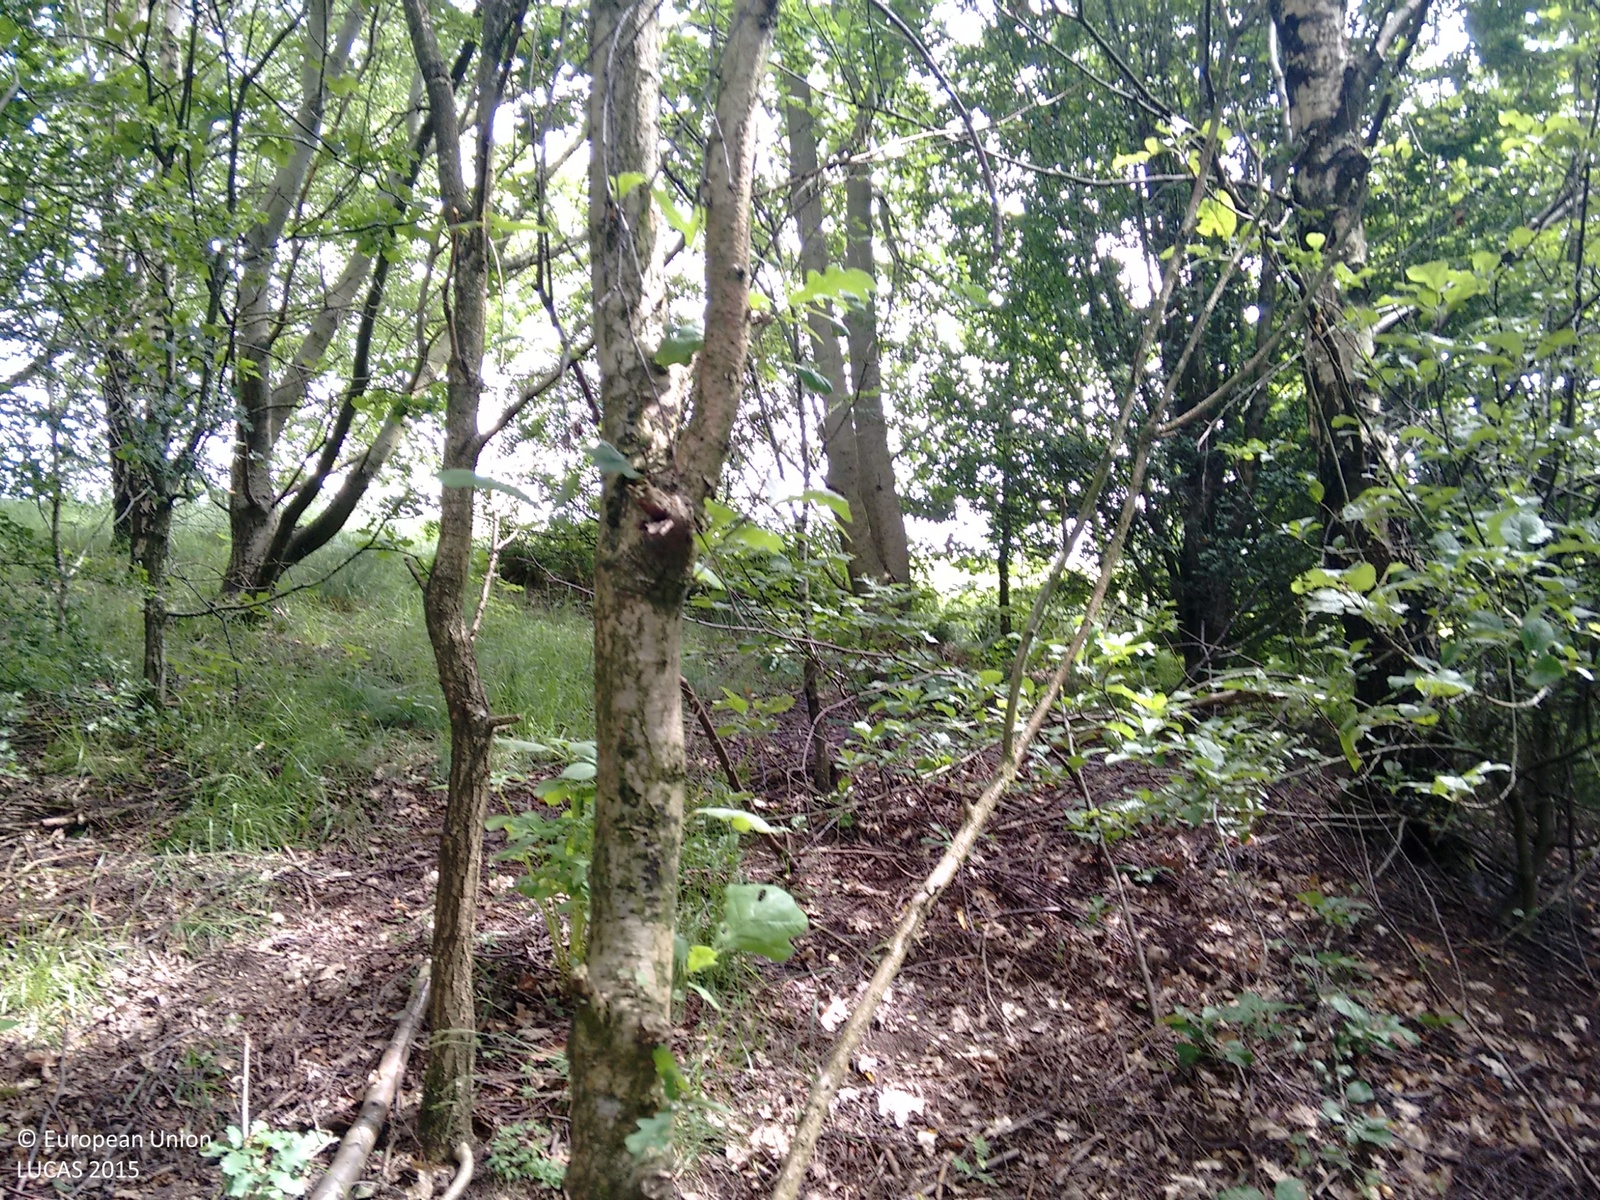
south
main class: Woodland
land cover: Broadleaved woodland
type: mesophytic deciduous forest
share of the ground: > 75 %
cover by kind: broadleaved forest trees 100 %
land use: Sport
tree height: > 5 m
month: June
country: GB
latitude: 53.4984
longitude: -2.1345
